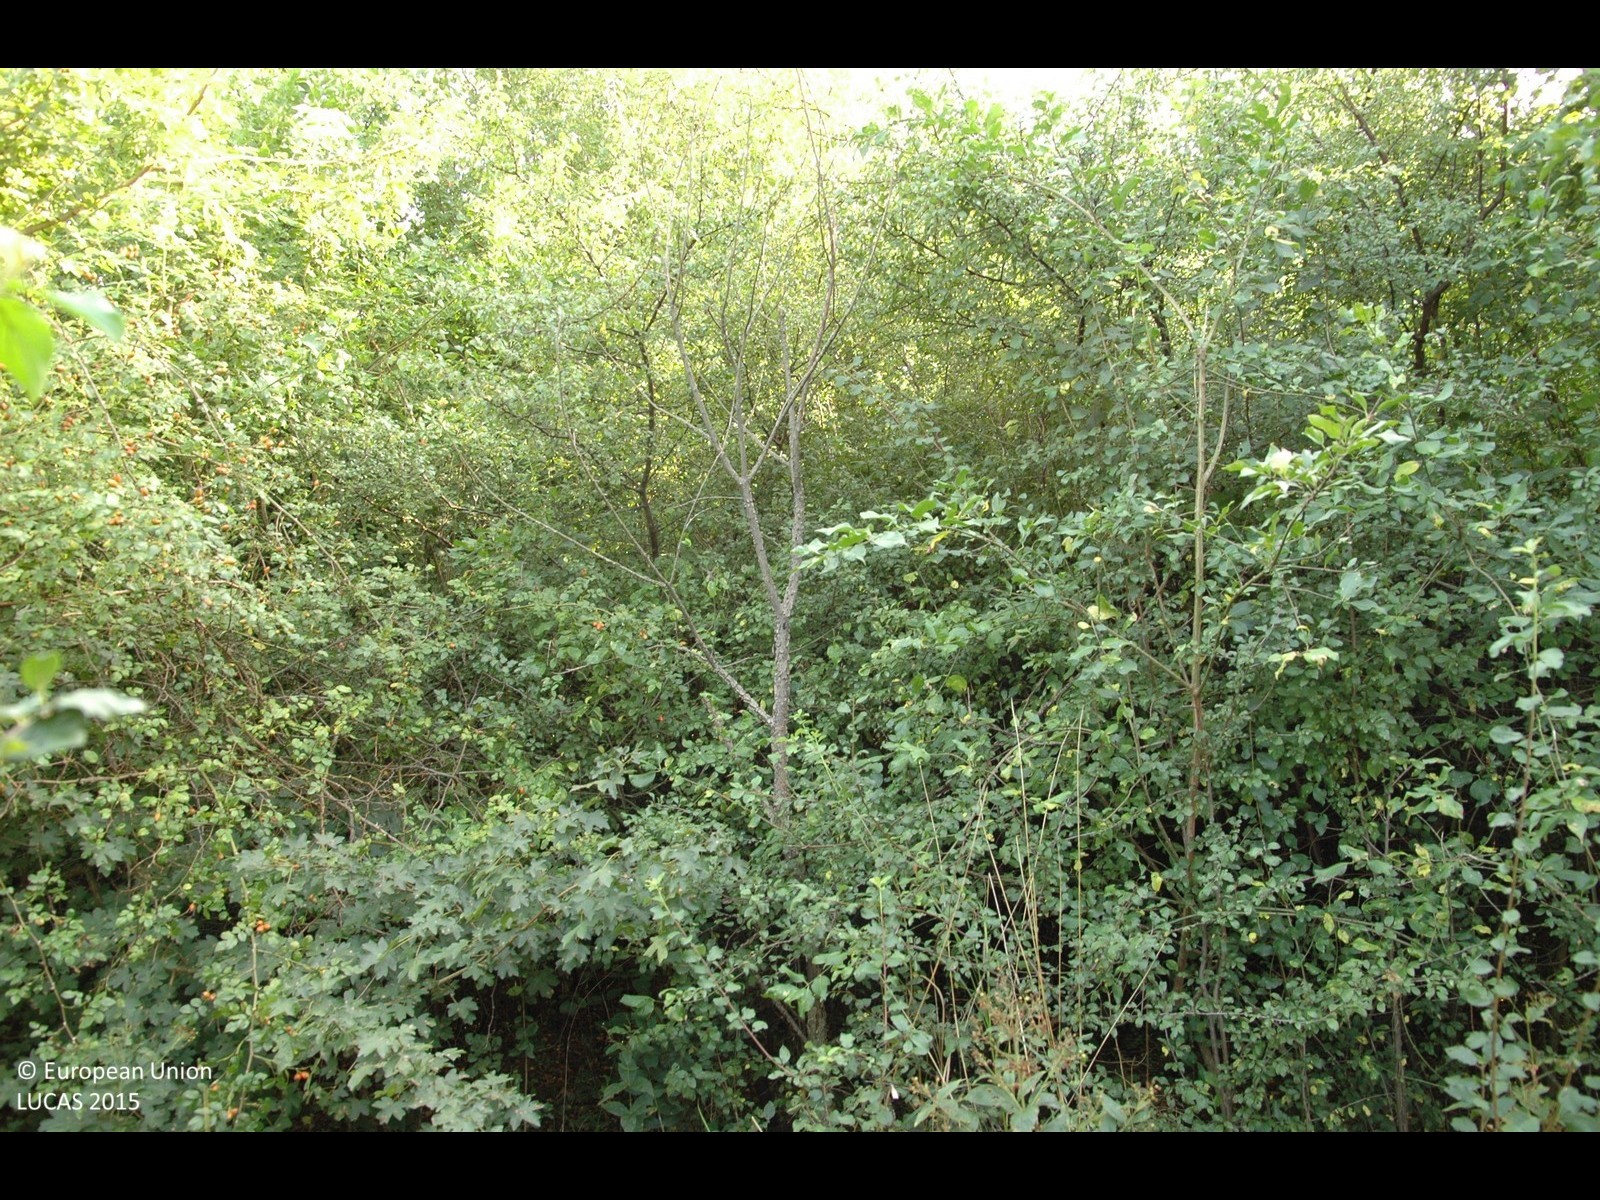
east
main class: Shrubland
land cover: Shrubland with sparse tree cover
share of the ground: > 75 %
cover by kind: shrubs 95 %, broadleaved forest trees 5 %
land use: Semi-natural and natural areas not in use
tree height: > 5 m
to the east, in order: Shrubland with sparse tree cover; Shrubland without tree cover; Shrubland with sparse tree cover; Shrubland without tree cover
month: August
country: HR
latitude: 45.8152
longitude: 16.1113
